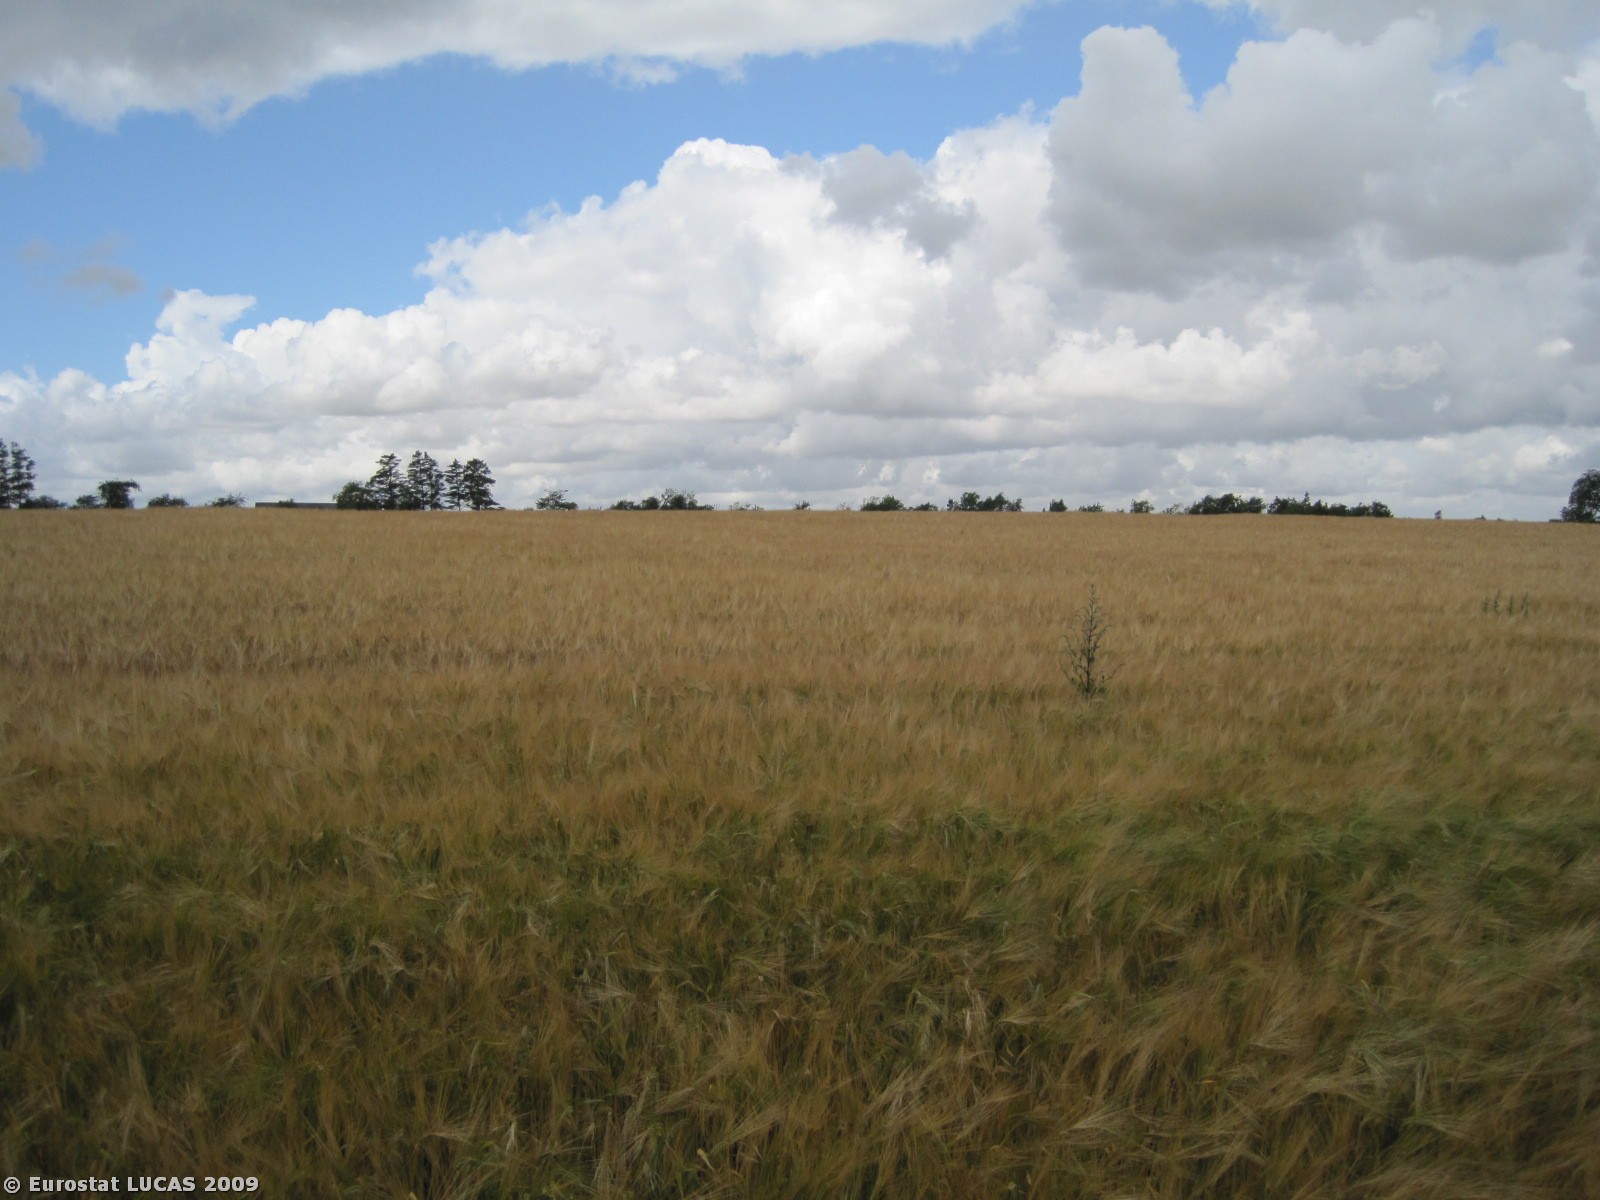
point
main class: Cropland
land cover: Barley
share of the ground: > 75 %
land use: Agriculture (excluding fallow land and kitchen gardens)
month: July
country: DK
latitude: 56.3804
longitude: 8.8516
